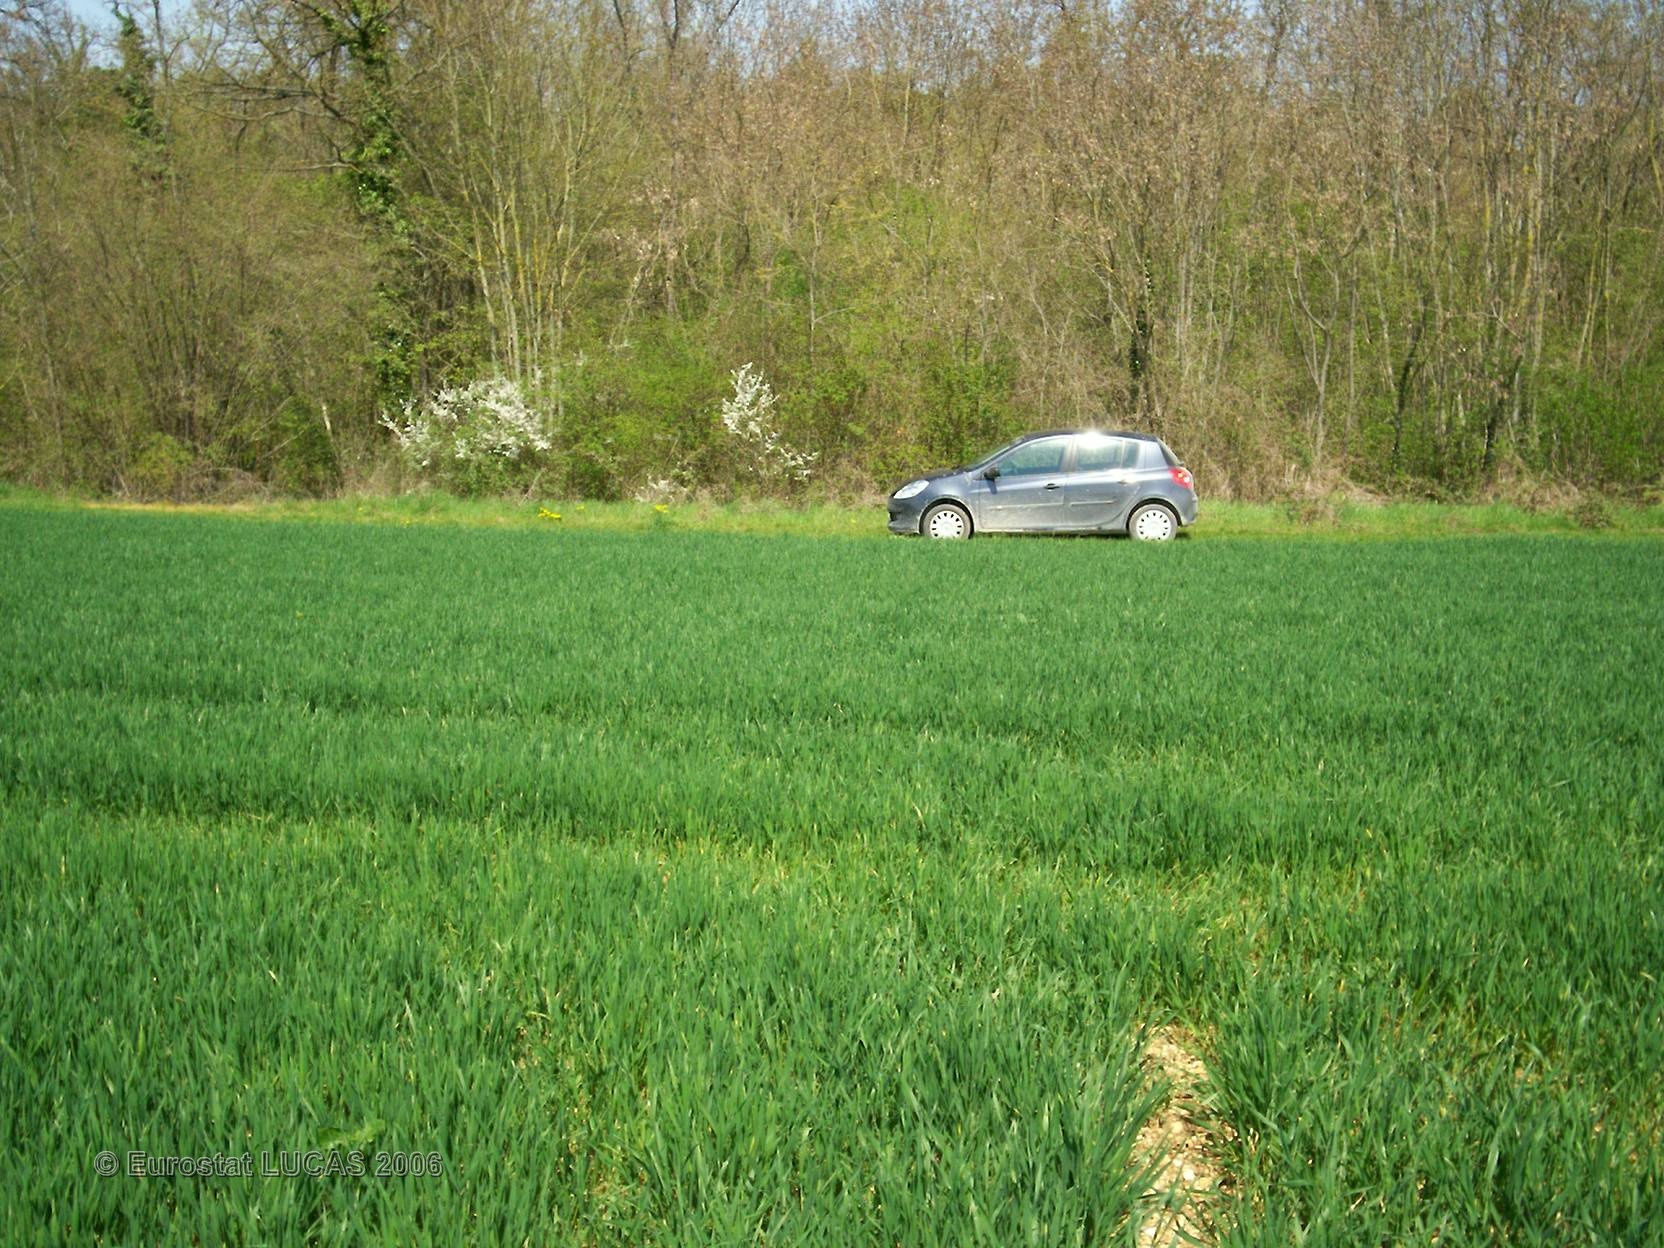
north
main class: Cropland
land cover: Common wheat
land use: Agriculture (excluding fallow land and kitchen gardens)
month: April
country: FR
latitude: 48.4440
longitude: 4.4409
